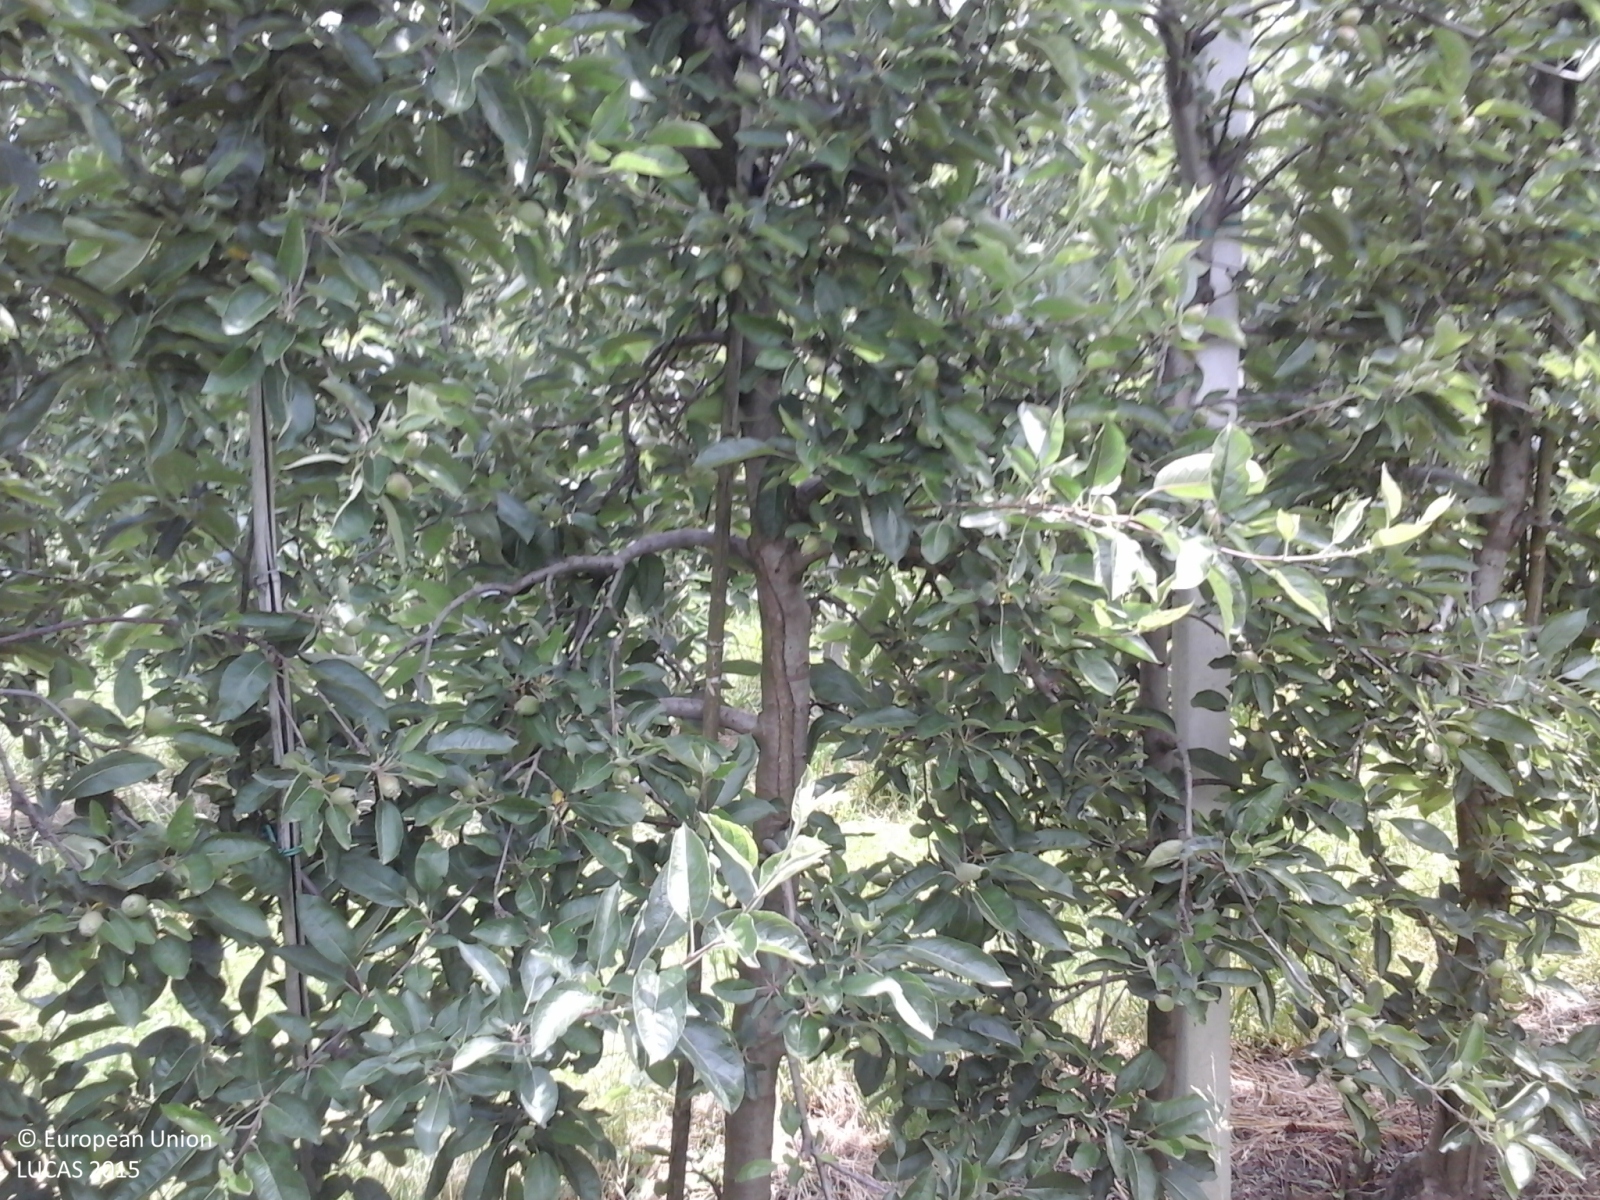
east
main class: Cropland
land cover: Apple fruit
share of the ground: > 75 %
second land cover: Grassland without tree/shrub cover
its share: > 75 %
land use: Agriculture (excluding fallow land and kitchen gardens)
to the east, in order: Apple fruit; Grassland without tree/shrub cover; Artificial constructions in urban areas
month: May
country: IT
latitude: 46.6182
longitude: 10.8217
